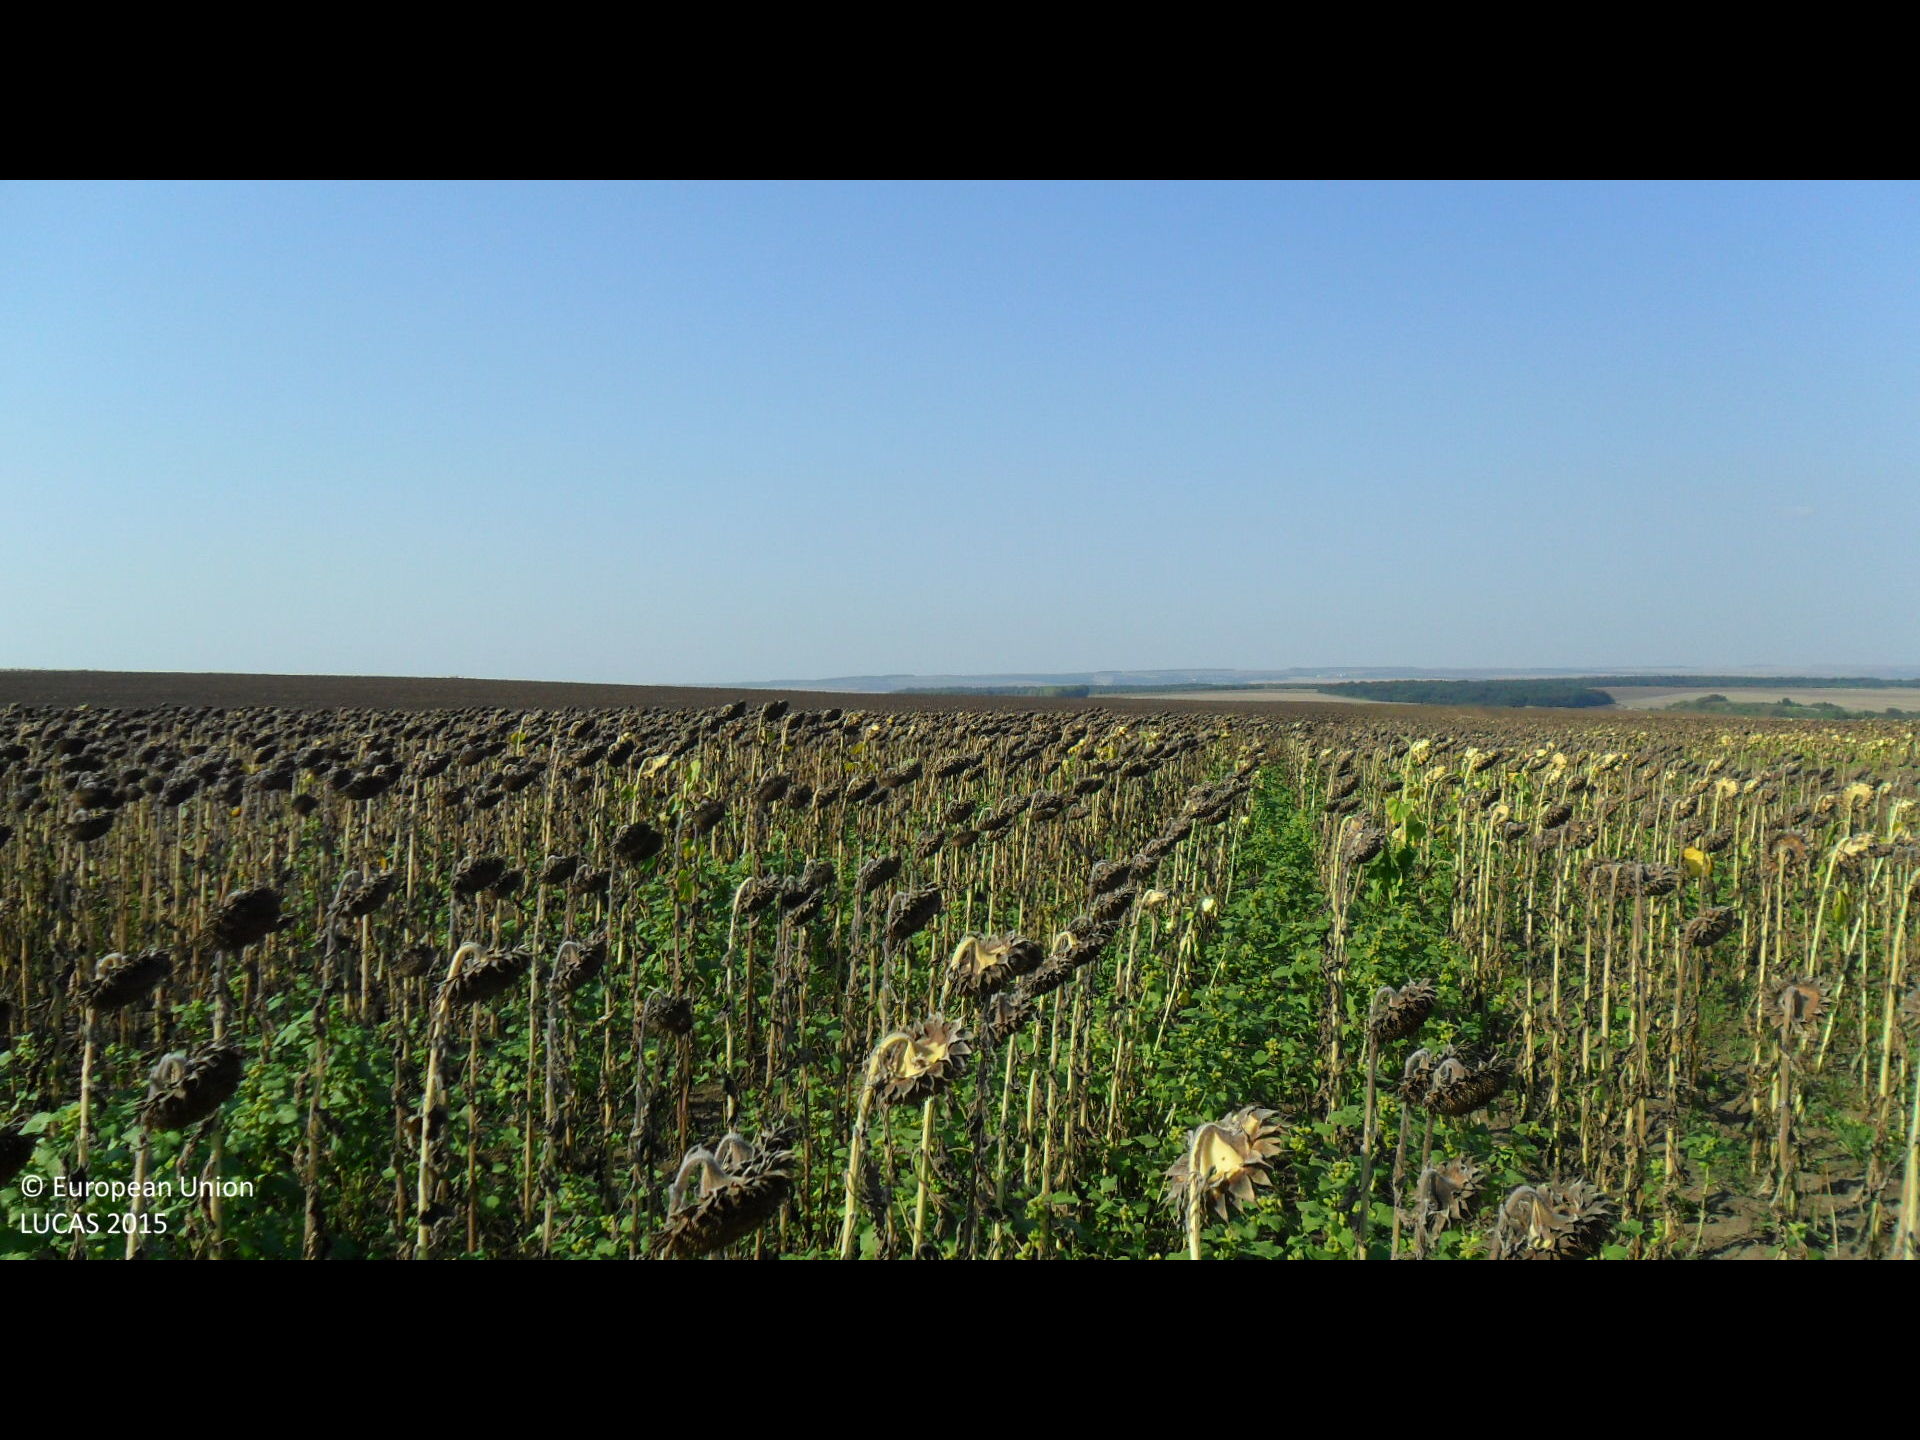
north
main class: Cropland
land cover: Sunflower
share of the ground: > 75 %
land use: Agriculture (excluding fallow land and kitchen gardens)
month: August
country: BG
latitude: 43.2342
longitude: 26.6422
